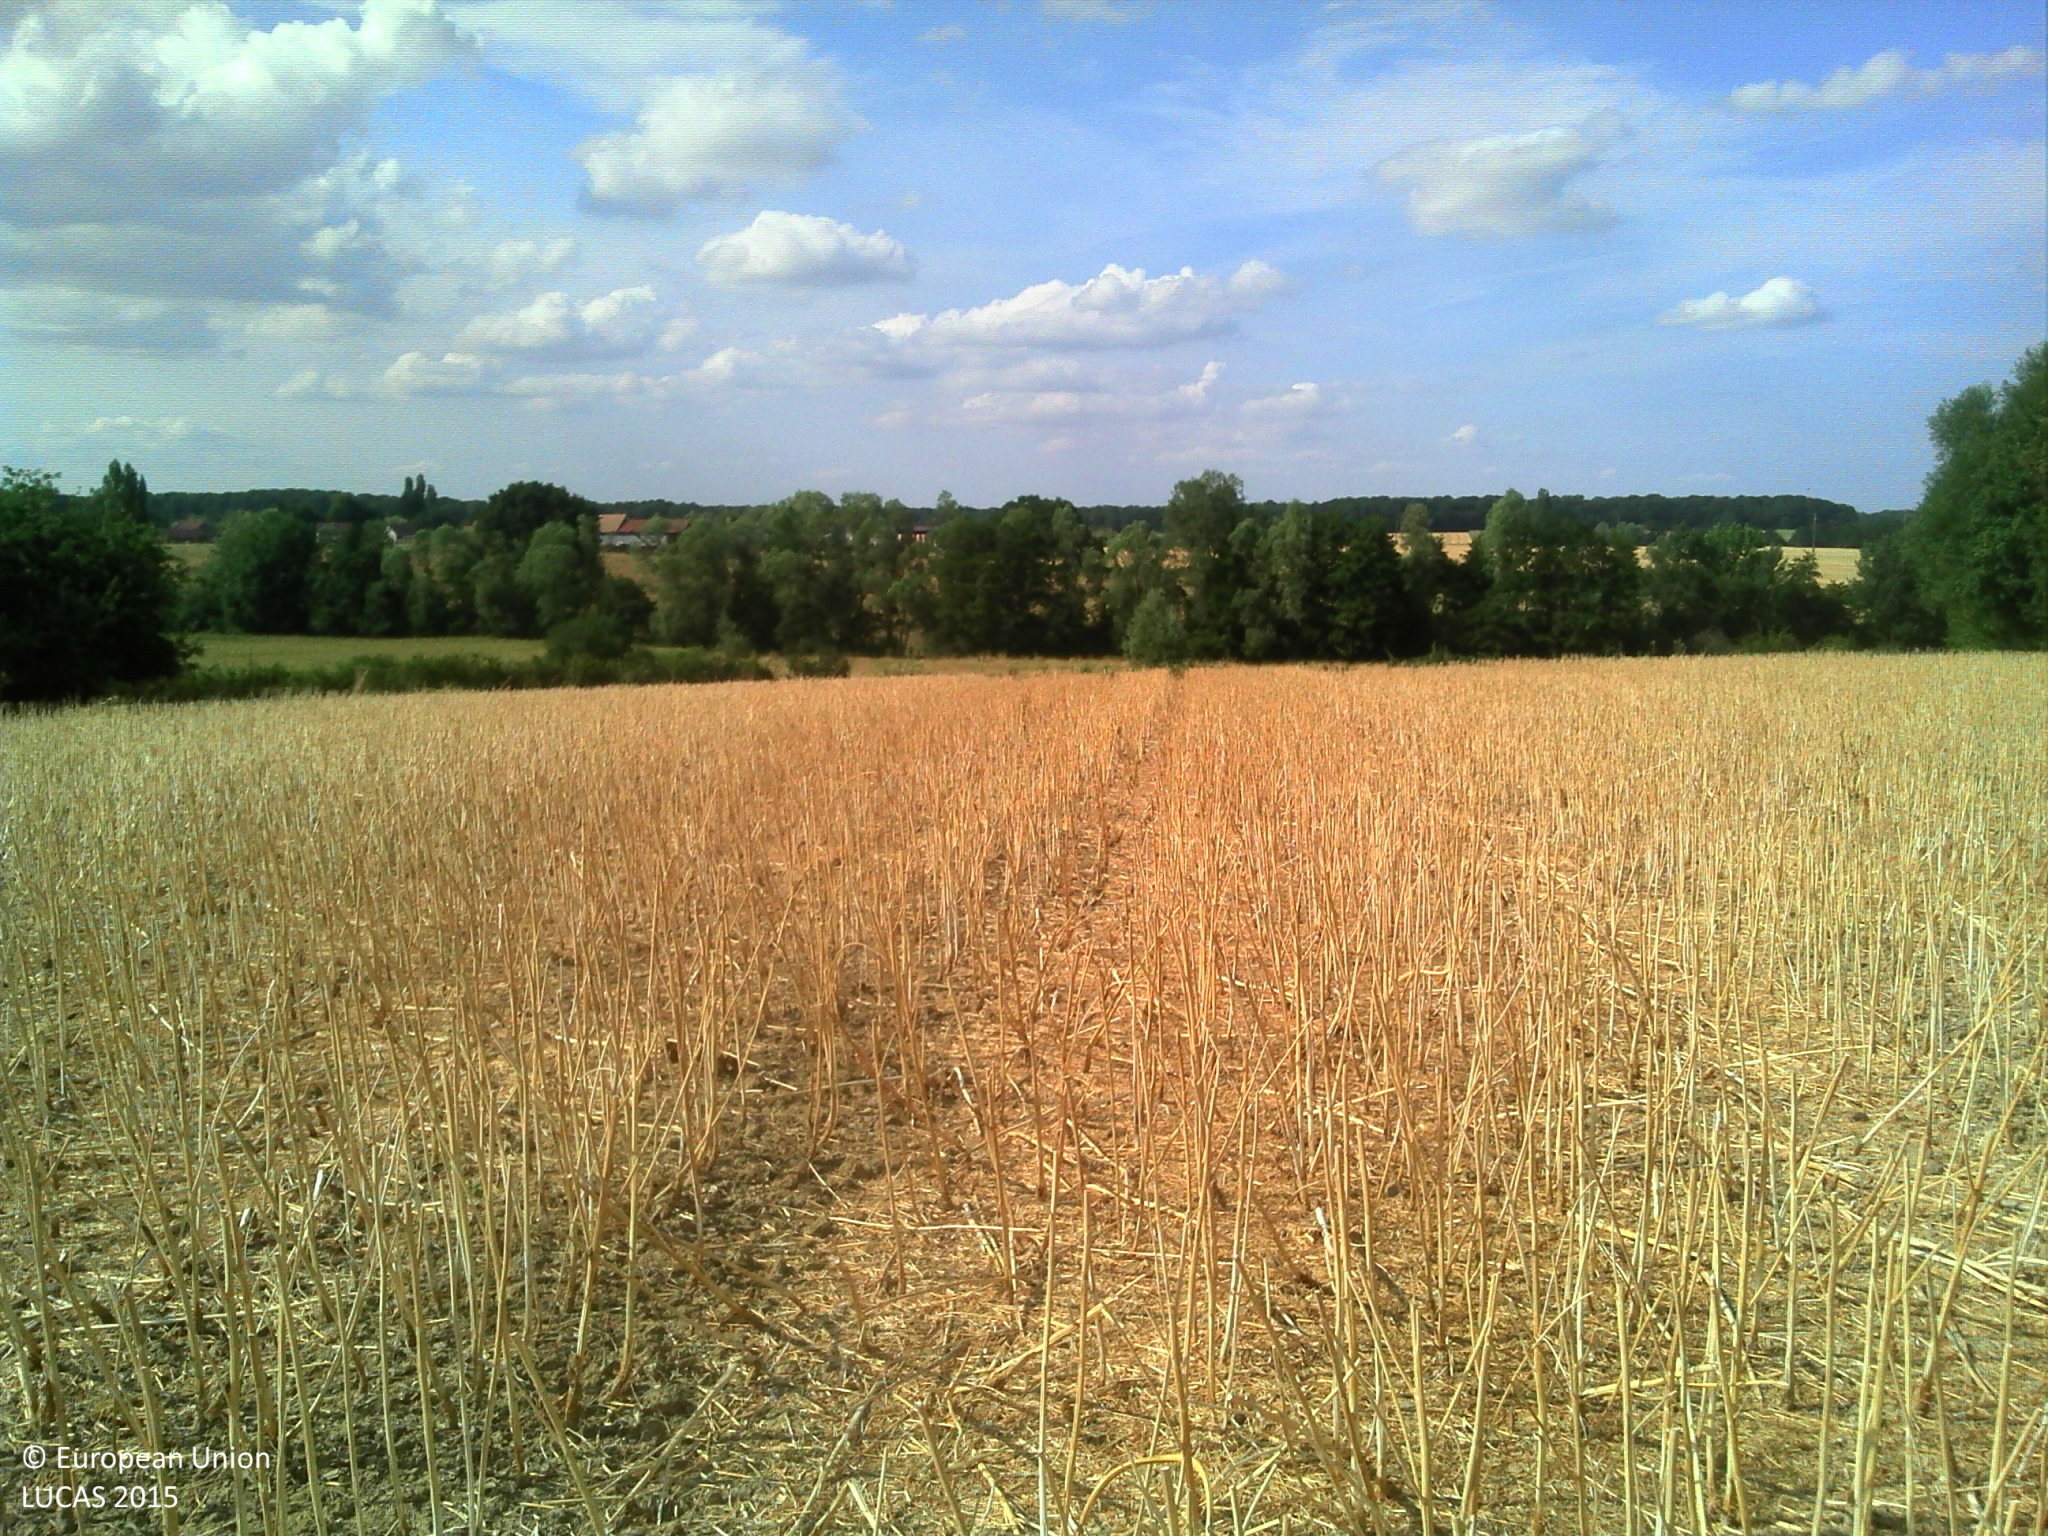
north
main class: Cropland
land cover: Rape and turnip rape
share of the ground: > 75 %
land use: Agriculture (excluding fallow land and kitchen gardens)
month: July
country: FR
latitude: 46.8994
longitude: 4.9475
